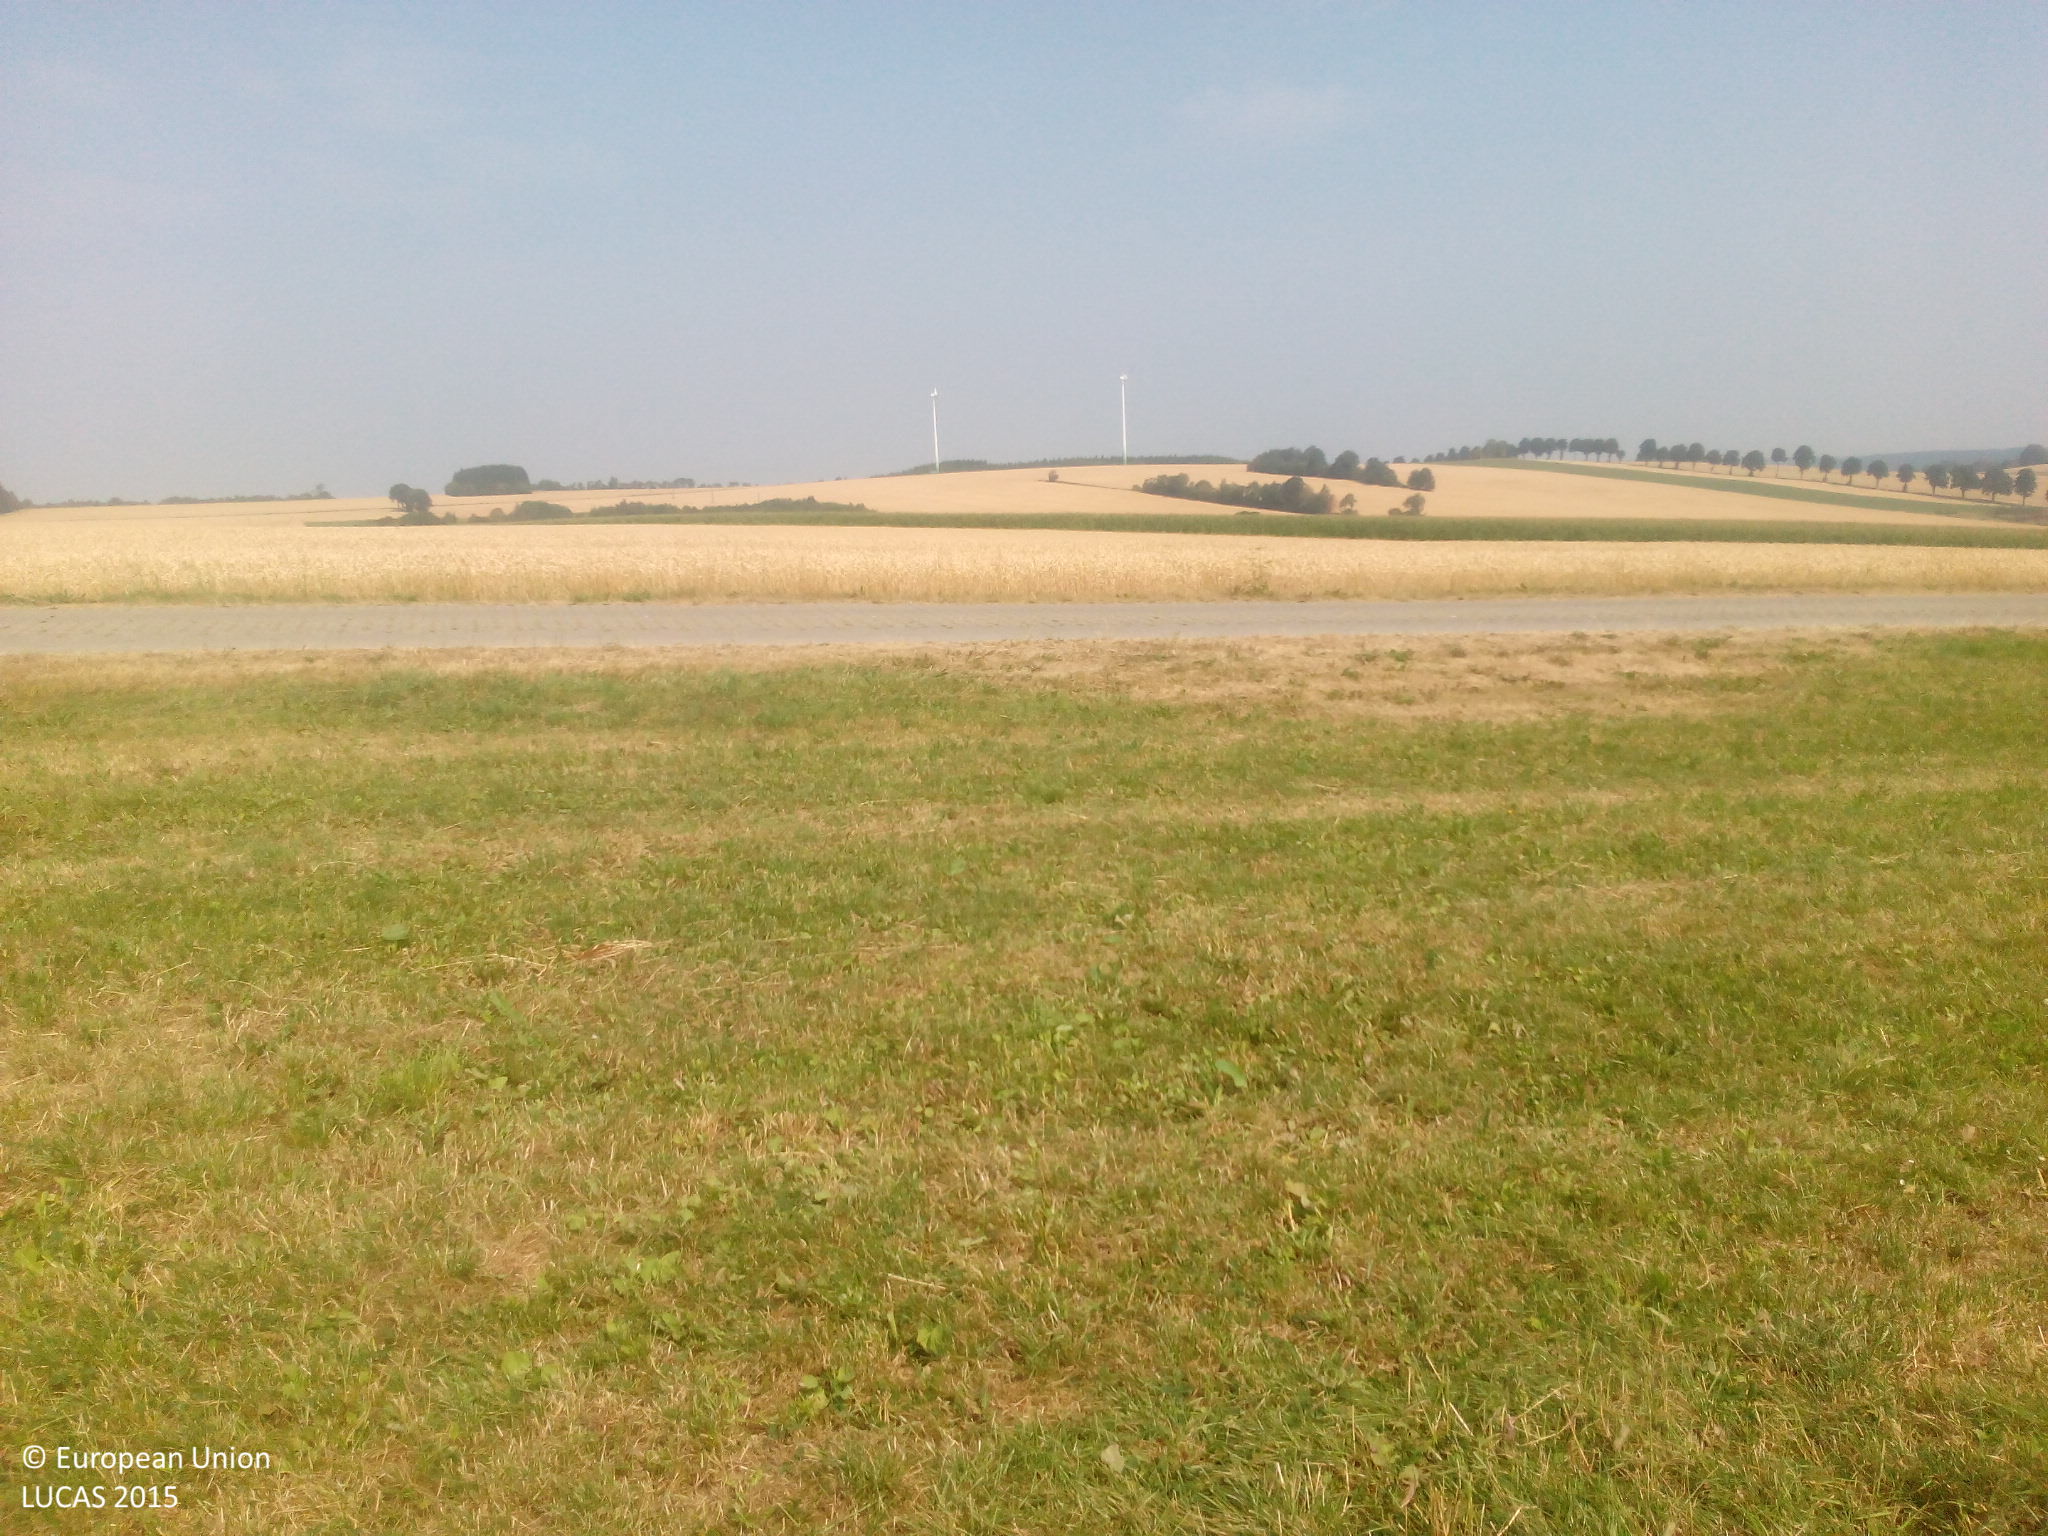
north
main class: Grassland
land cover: Grassland without tree/shrub cover
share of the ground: > 75 %
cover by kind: herbaceous plants 100 %
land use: Agriculture (excluding fallow land and kitchen gardens)
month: August
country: DE
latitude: 50.7458
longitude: 13.3875
